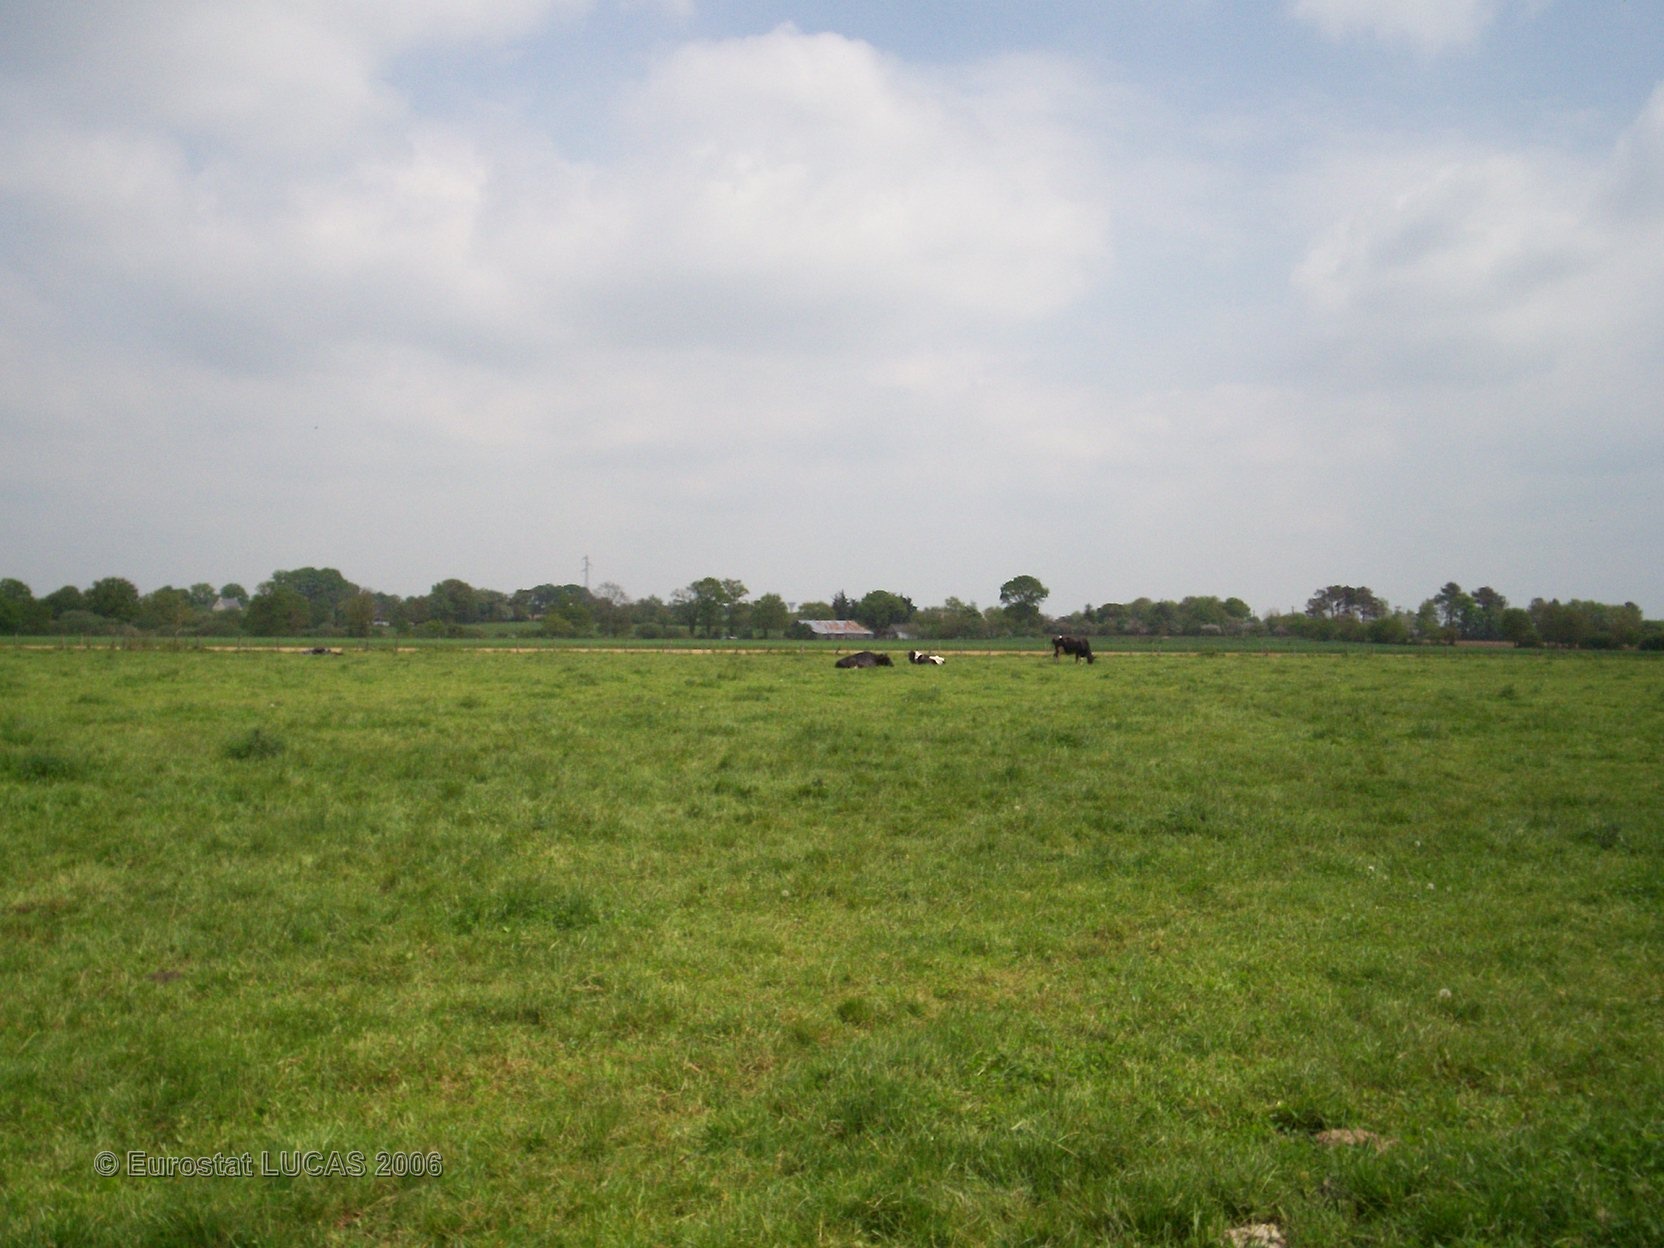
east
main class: Grassland
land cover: Grassland without tree/shrub cover
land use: Agriculture (excluding fallow land and kitchen gardens)
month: May
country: FR
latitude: 47.5390
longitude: -2.2356
